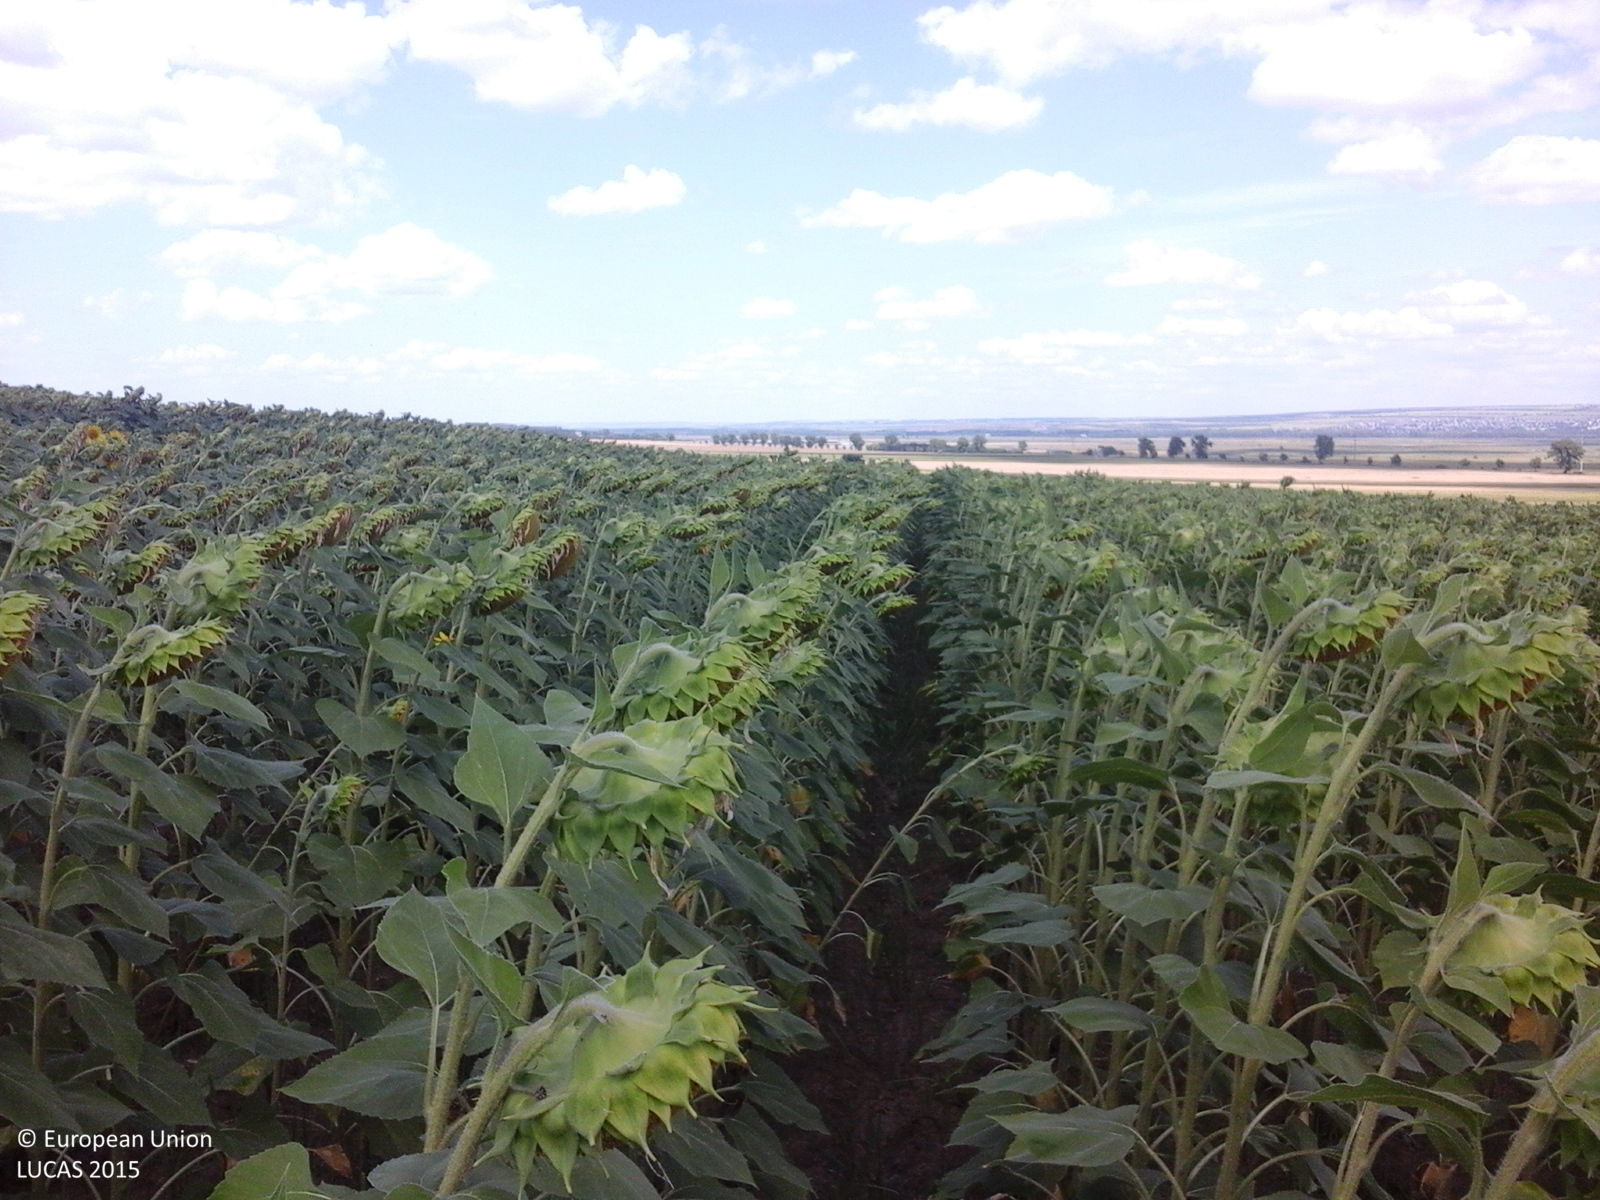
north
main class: Cropland
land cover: Sunflower
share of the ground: > 75 %
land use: Agriculture (excluding fallow land and kitchen gardens)
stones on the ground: < 10 %
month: July
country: RO
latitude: 46.4356
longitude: 28.1836
